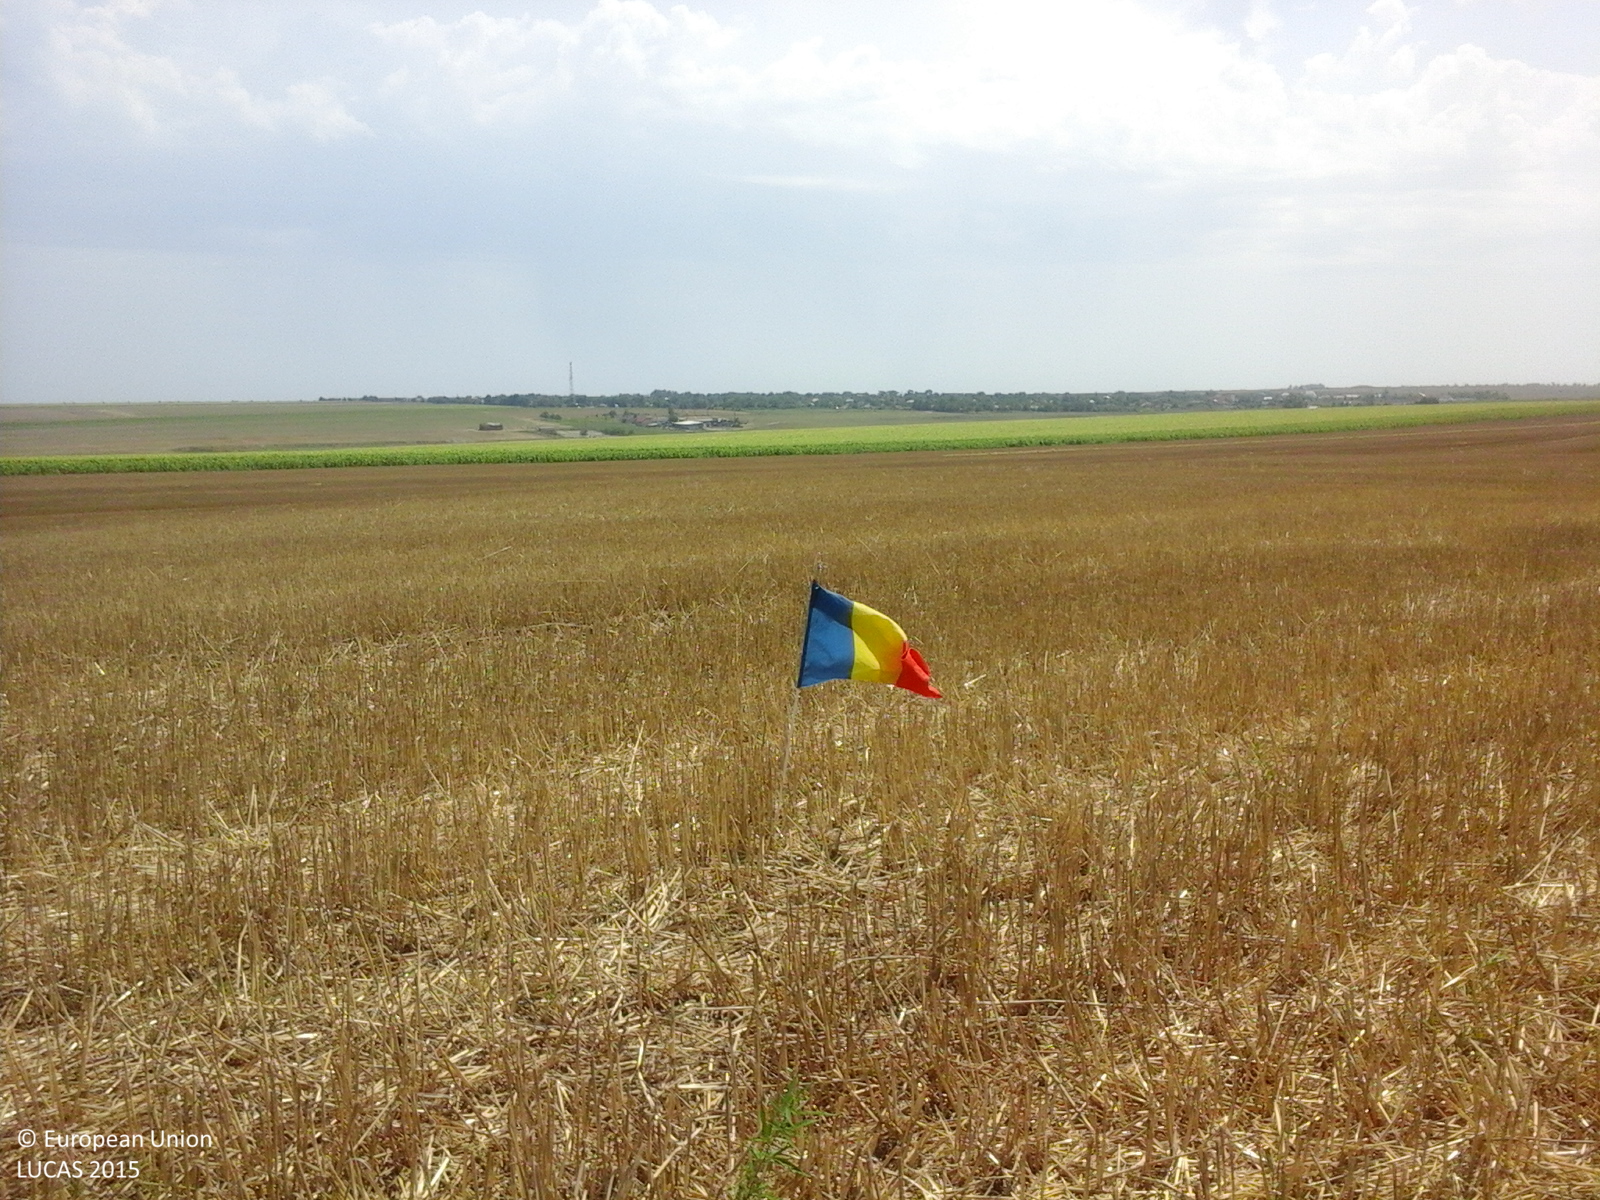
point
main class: Cropland
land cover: Common wheat
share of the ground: > 75 %
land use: Agriculture (excluding fallow land and kitchen gardens)
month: August
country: RO
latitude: 44.0797
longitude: 28.4616
